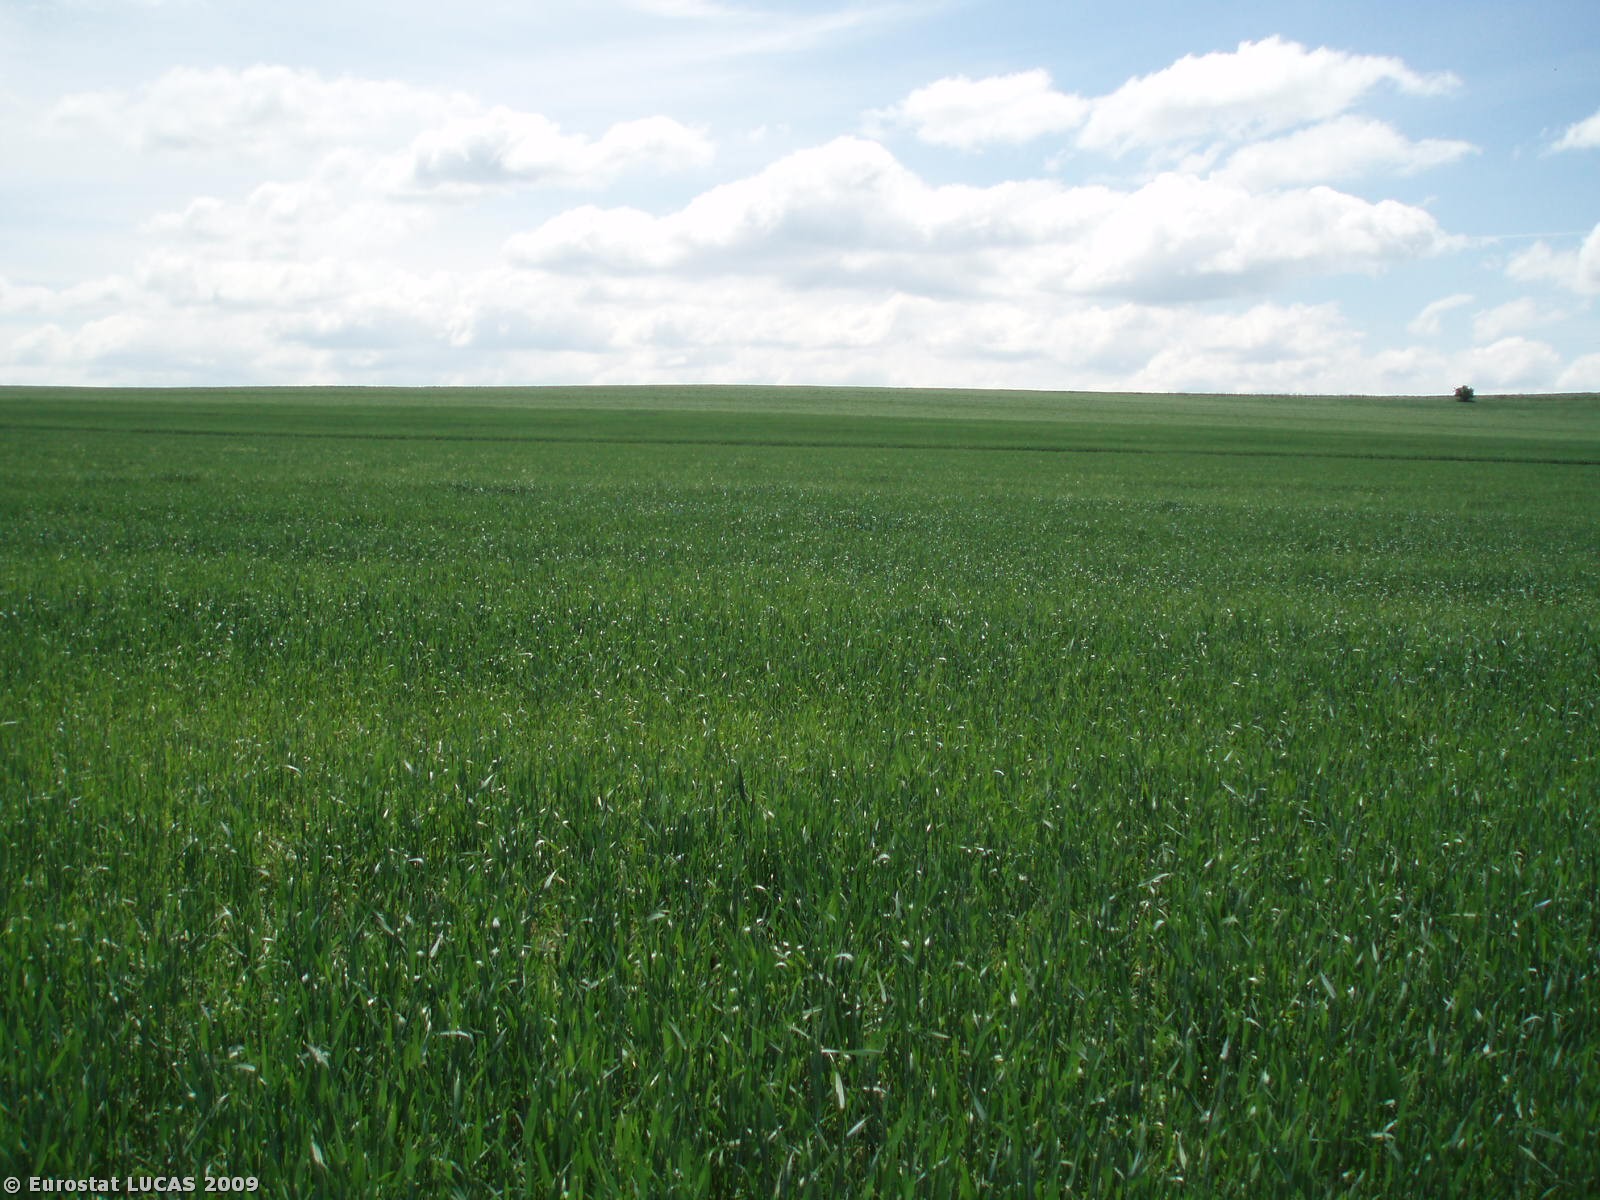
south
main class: Cropland
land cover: Common wheat
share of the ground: > 75 %
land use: Agriculture (excluding fallow land and kitchen gardens)
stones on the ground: < 10 %
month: June
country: CZ
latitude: 50.4217
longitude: 13.9560
